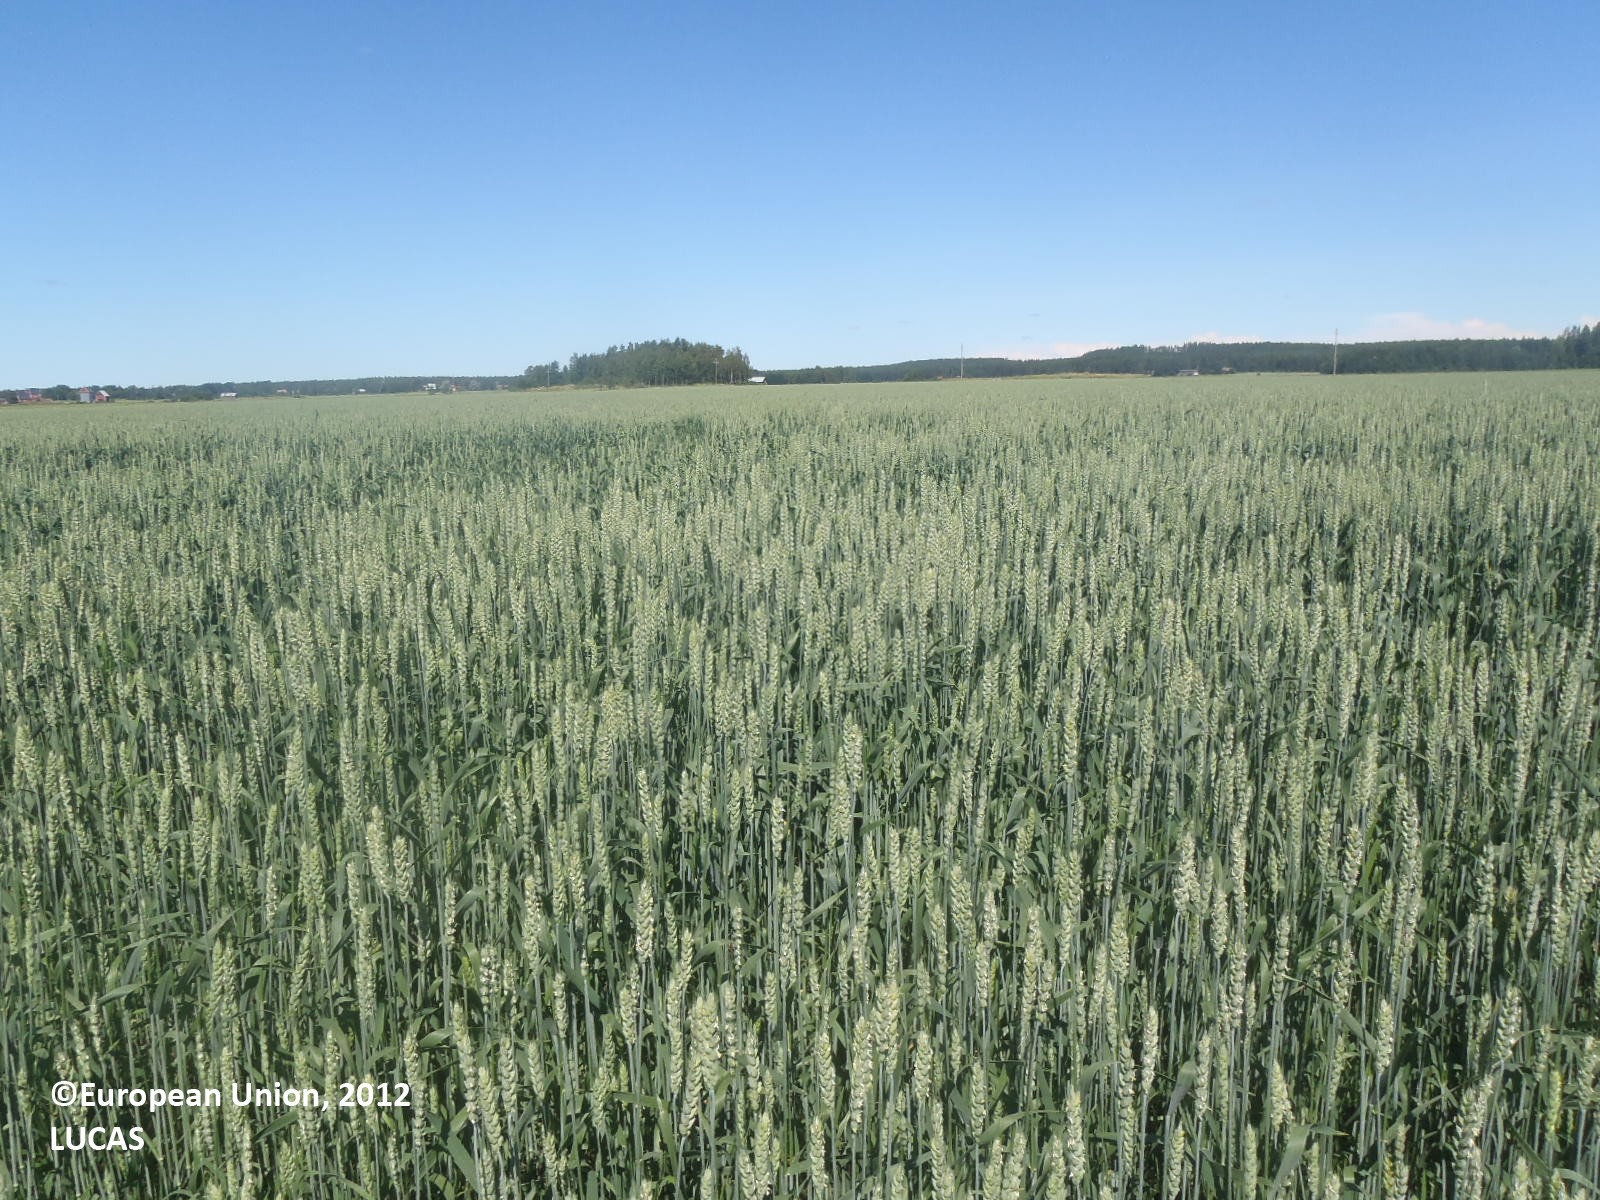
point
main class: Cropland
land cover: Common wheat
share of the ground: > 75 %
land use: Agriculture (excluding fallow land and kitchen gardens)
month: July
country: FI
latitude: 61.0347
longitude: 21.9993
